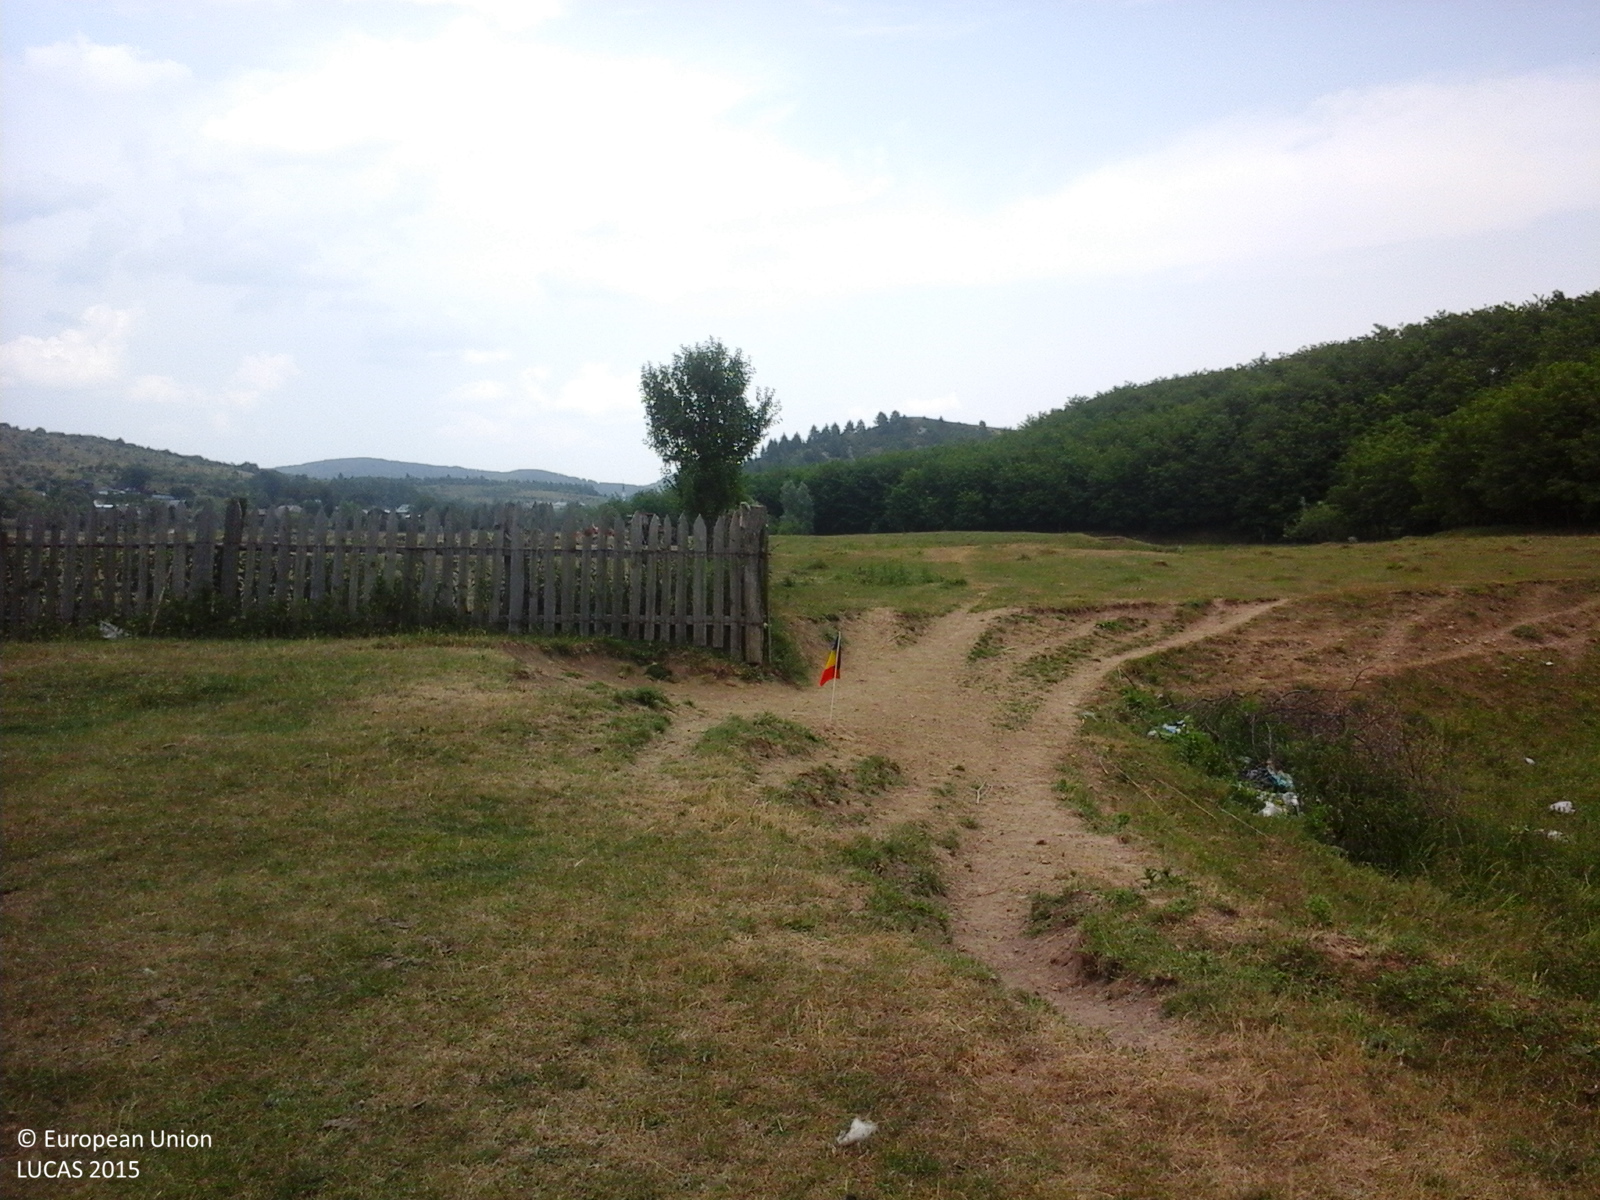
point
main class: Grassland
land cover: Grassland without tree/shrub cover
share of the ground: > 75 %
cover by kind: herbaceous plants 100 %
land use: Agriculture (excluding fallow land and kitchen gardens)
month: June
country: RO
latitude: 47.2046
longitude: 26.2792
